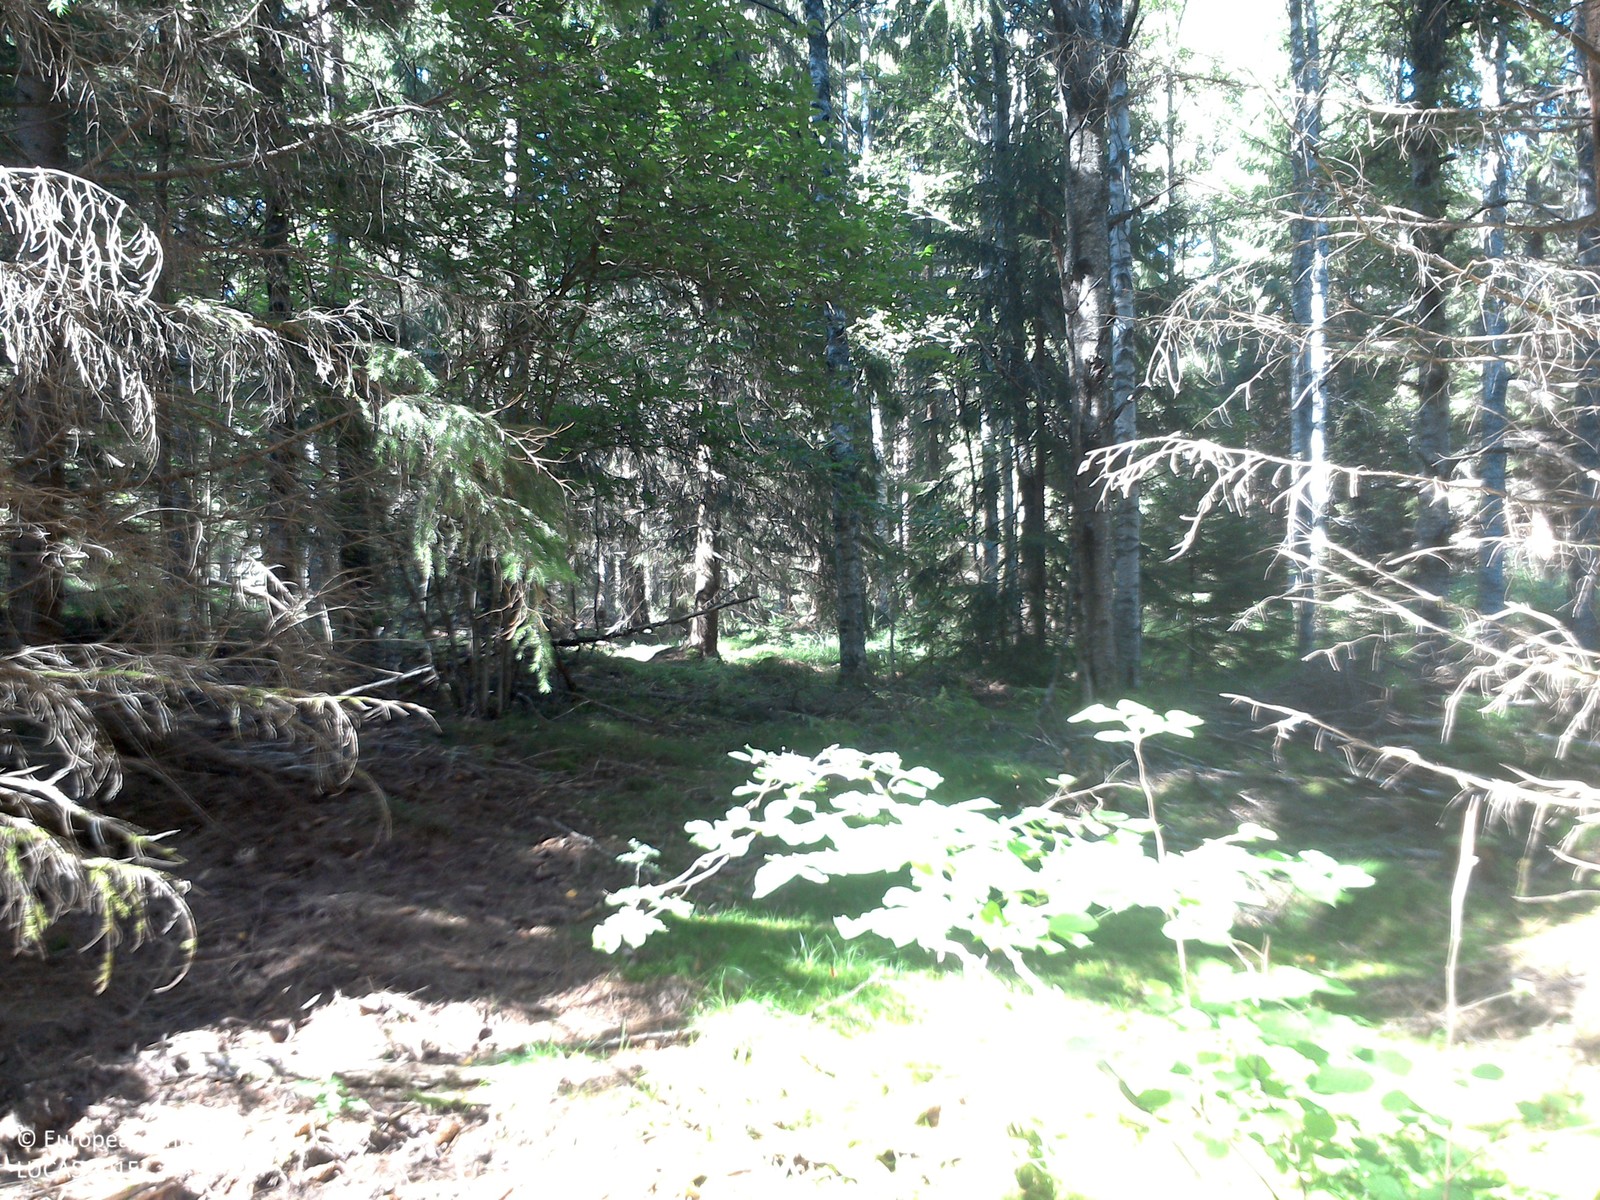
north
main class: Woodland
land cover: Spruce dominated coniferous woodland
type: boreal forest
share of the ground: > 75 %
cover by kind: coniferous forest trees 85 %, herbaceous plants 5 %, lichens and mosses 5 %, unconsolidated bare surface 5 %
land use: Forestry
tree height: > 5 m
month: August
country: SE
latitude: 57.8915
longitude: 15.4780
